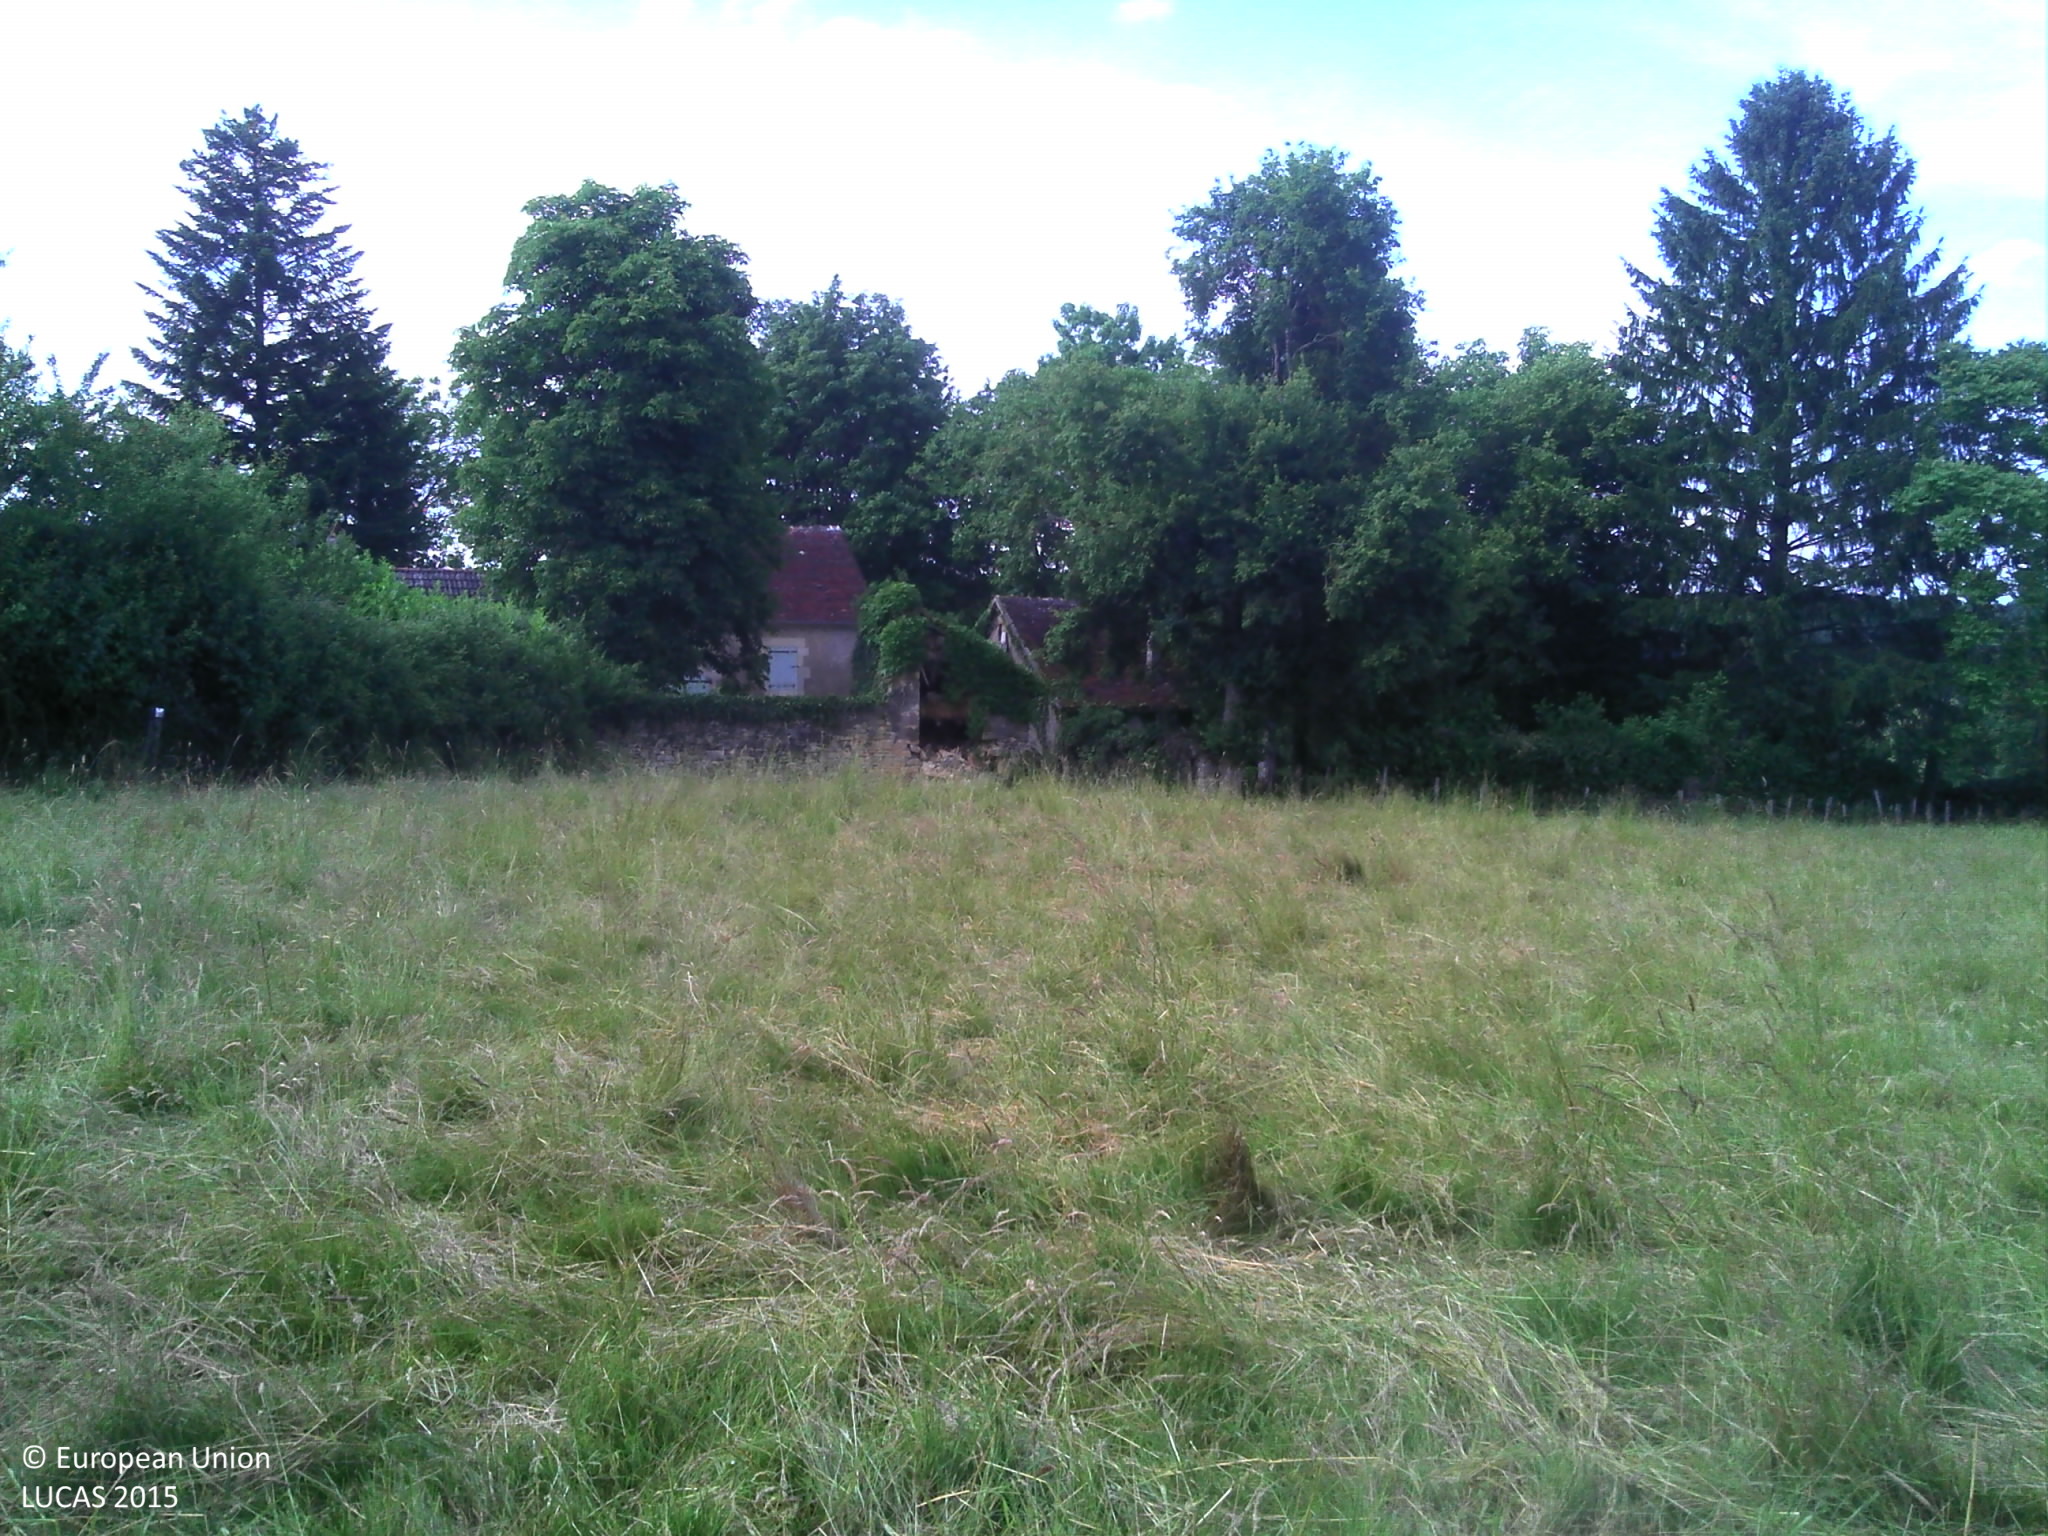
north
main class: Grassland
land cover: Grassland without tree/shrub cover
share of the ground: > 75 %
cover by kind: herbaceous plants 100 %
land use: Agriculture (excluding fallow land and kitchen gardens)
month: June
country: FR
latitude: 47.2202
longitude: 3.2216
